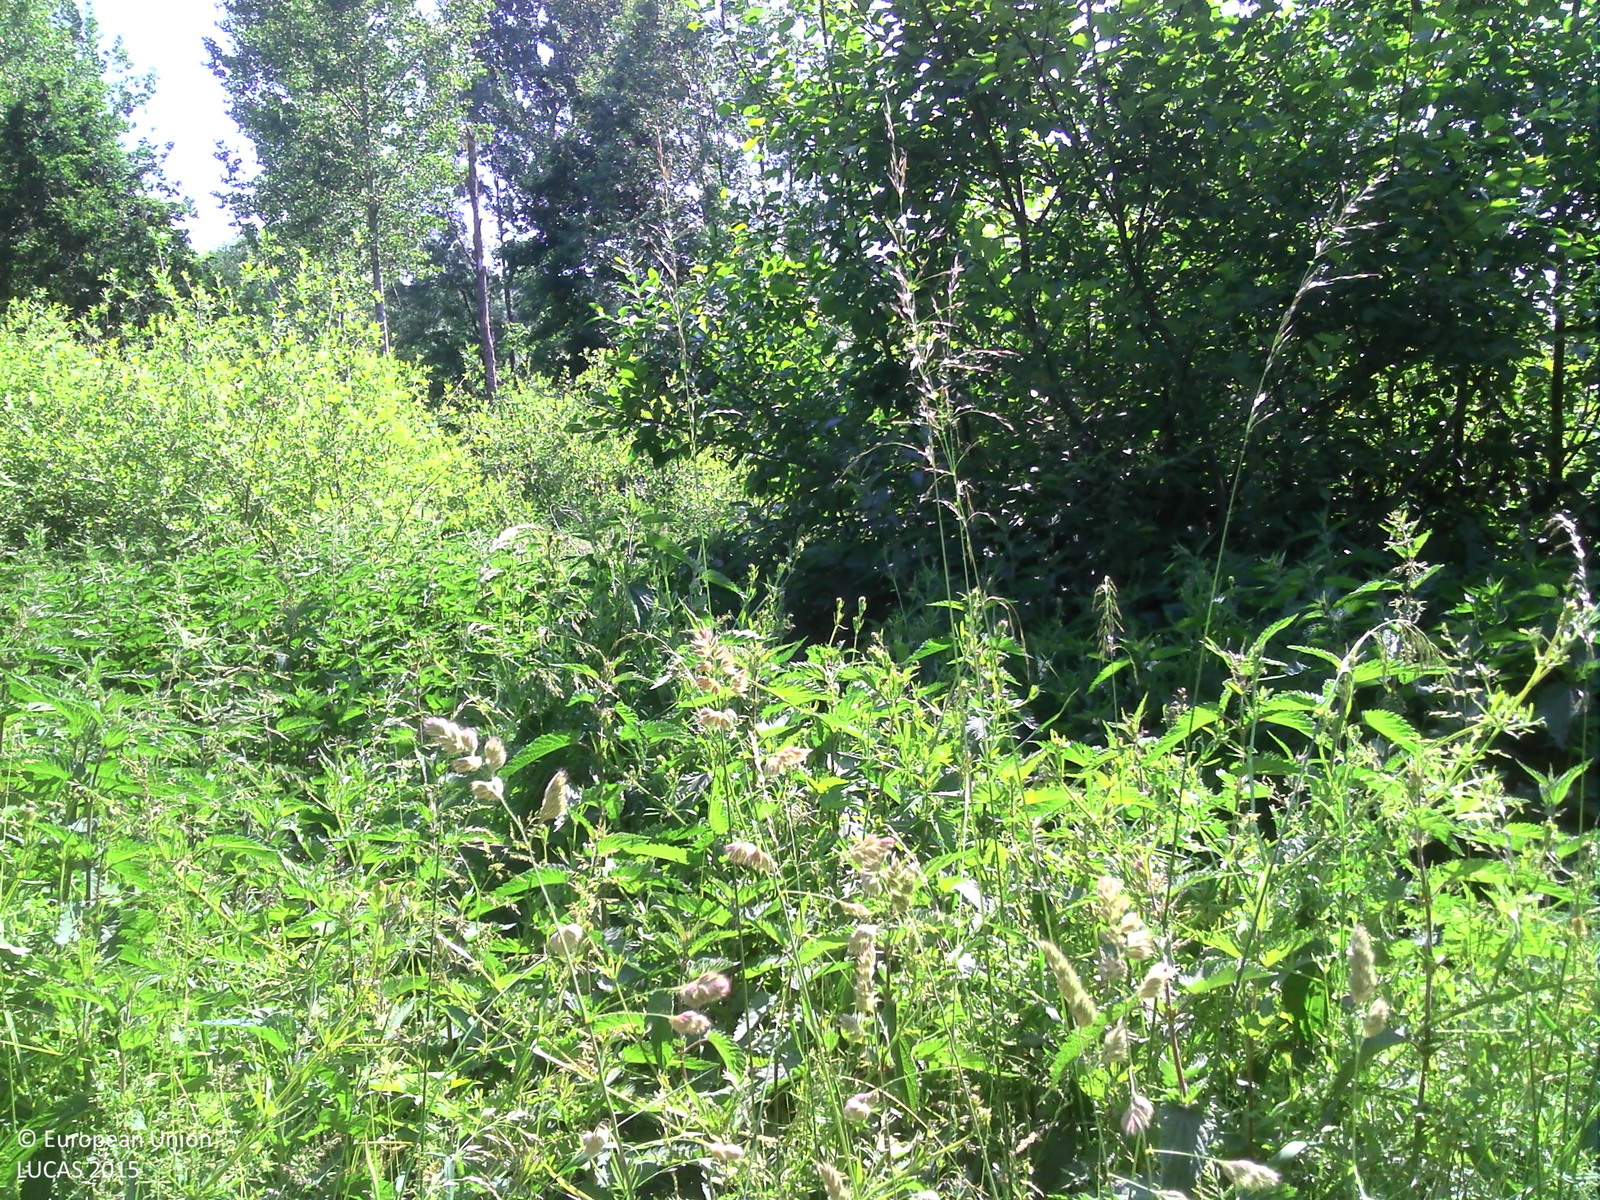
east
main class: Grassland
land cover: Spontaneously vegetated surfaces
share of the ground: > 75 %
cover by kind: herbaceous plants 100 %
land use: Semi-natural and natural areas not in use
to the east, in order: Spontaneously vegetated surfaces; Rivers and streams; Broadleaved woodland; Tracks; Grass margins; Electric lines; Railways; Electric lines; Spontaneously vegetated surfaces; Tracks; Broadleaved woodland; Grassland without tree/shrub cover; Broadleaved woodland
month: June
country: BE
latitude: 50.8158
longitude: 5.4988
